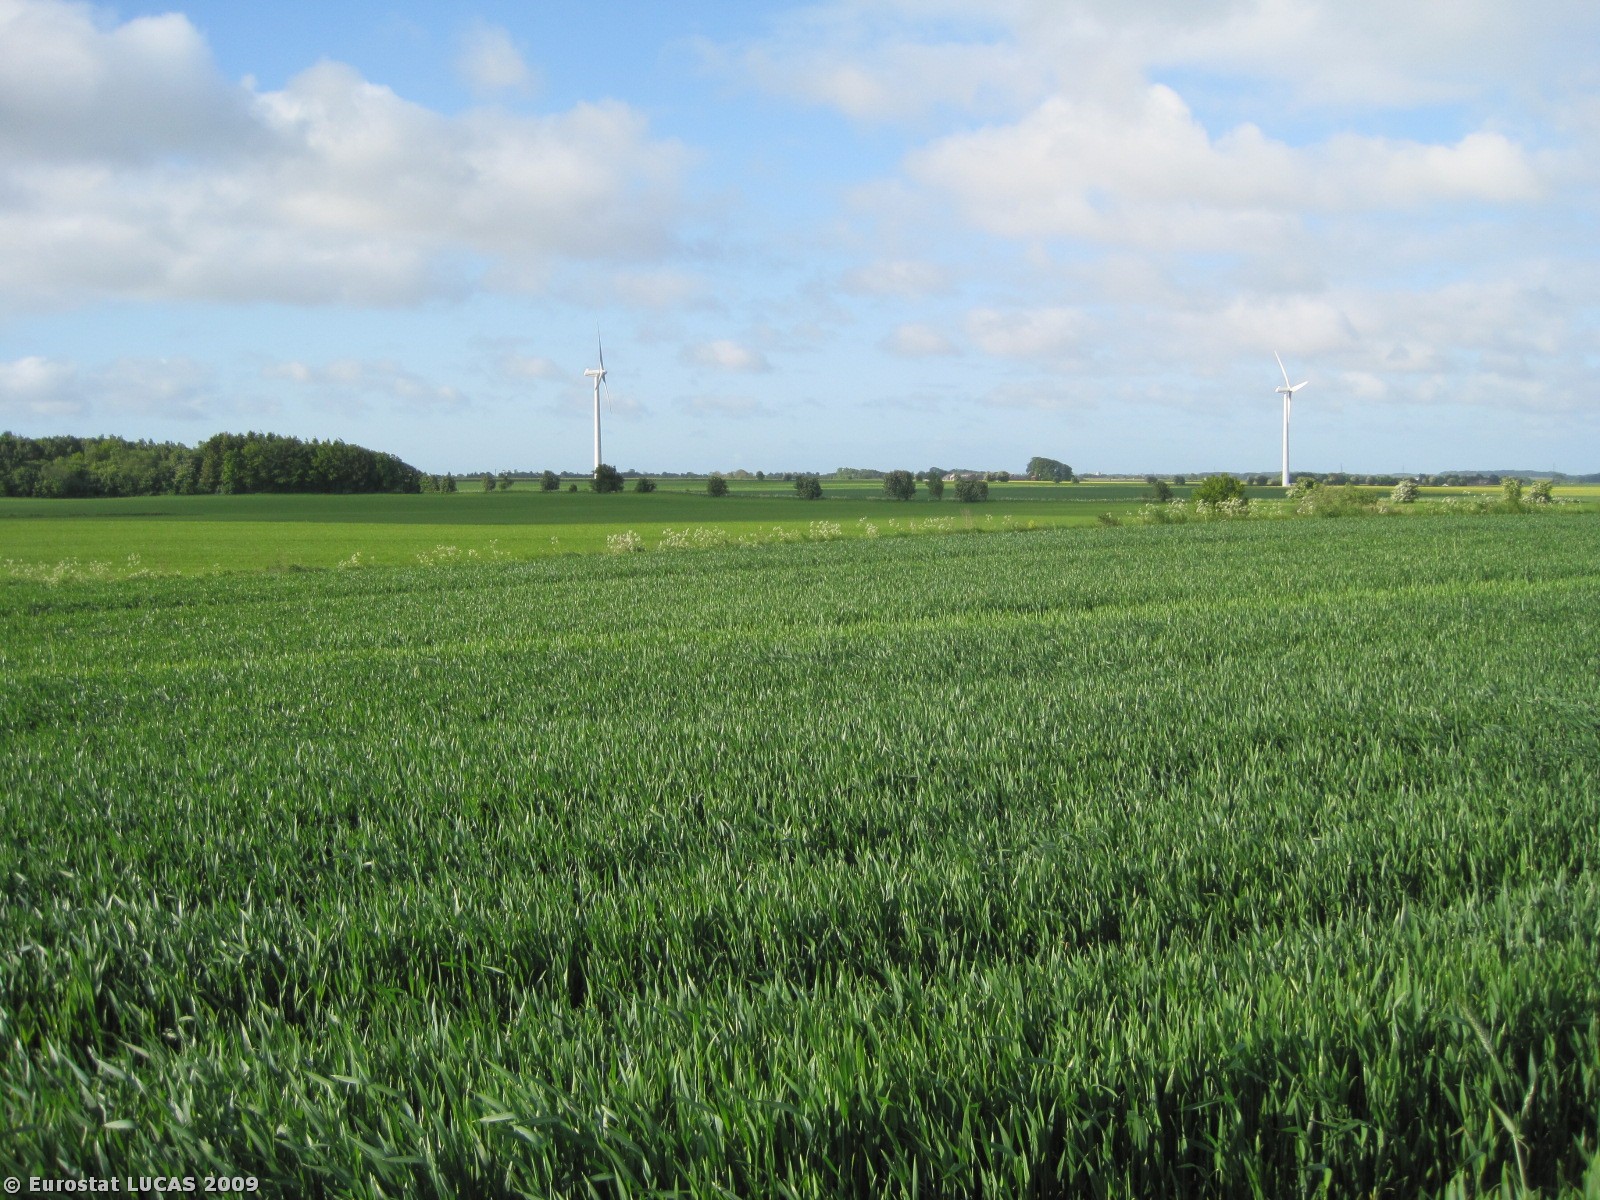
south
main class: Cropland
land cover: Common wheat
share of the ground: > 75 %
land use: Agriculture (excluding fallow land and kitchen gardens)
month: May
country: DK
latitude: 56.5472
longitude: 10.0812
